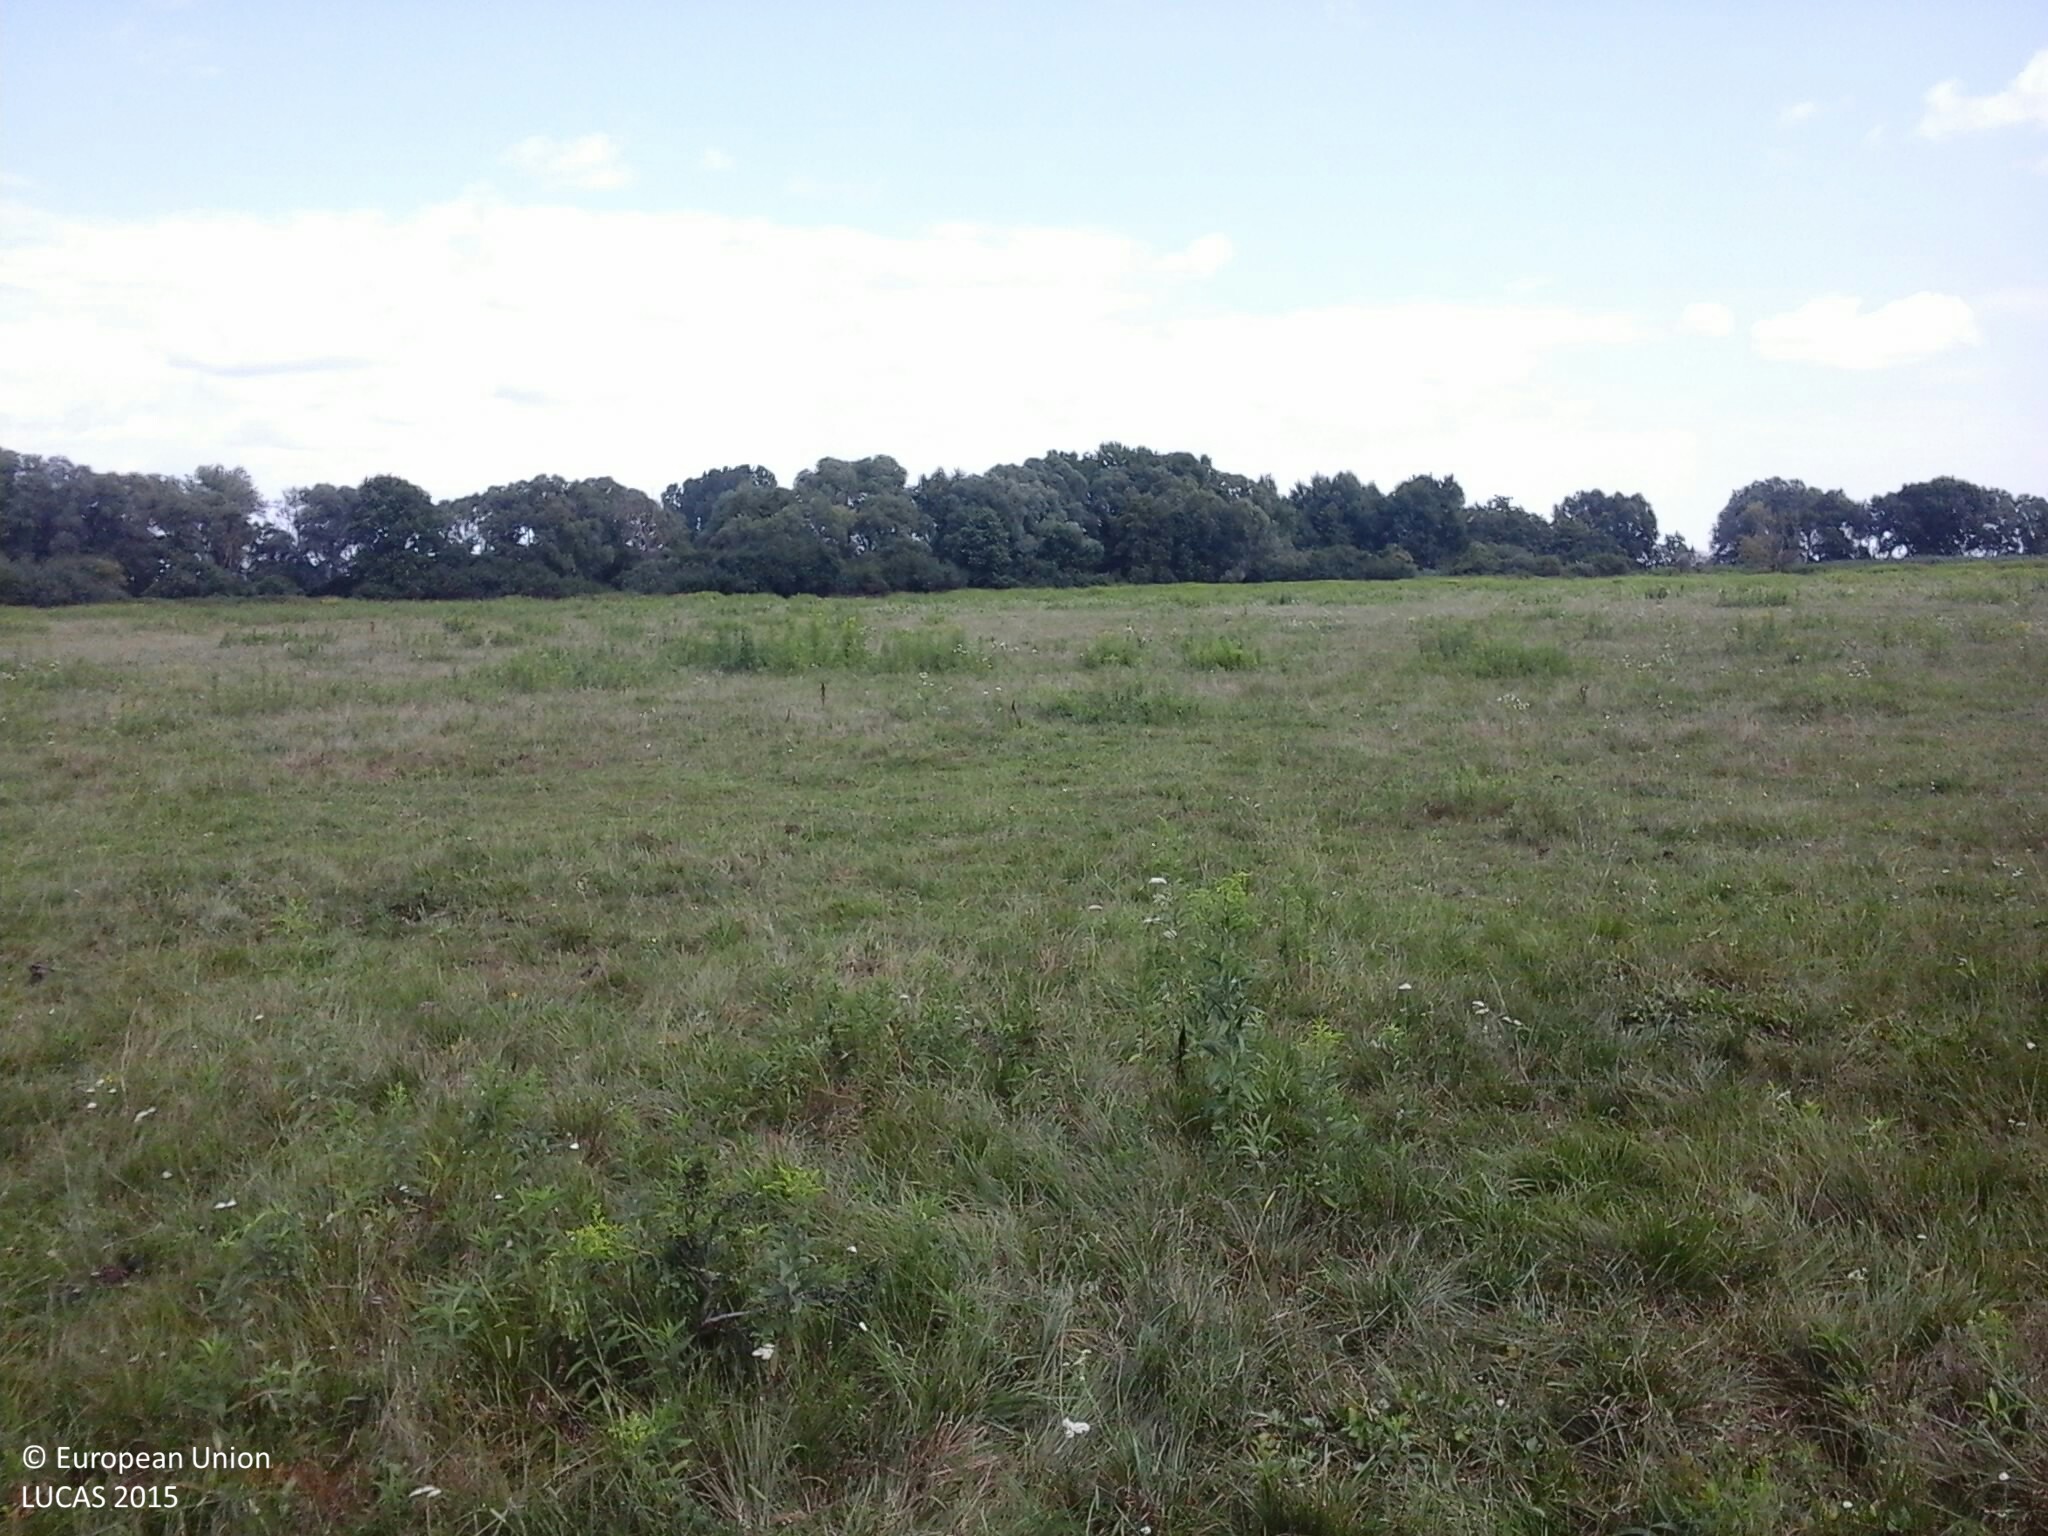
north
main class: Grassland
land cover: Grassland without tree/shrub cover
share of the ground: > 75 %
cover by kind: herbaceous plants 100 %
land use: Agriculture (excluding fallow land and kitchen gardens)
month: July
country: HU
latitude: 47.0407
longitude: 16.4646
